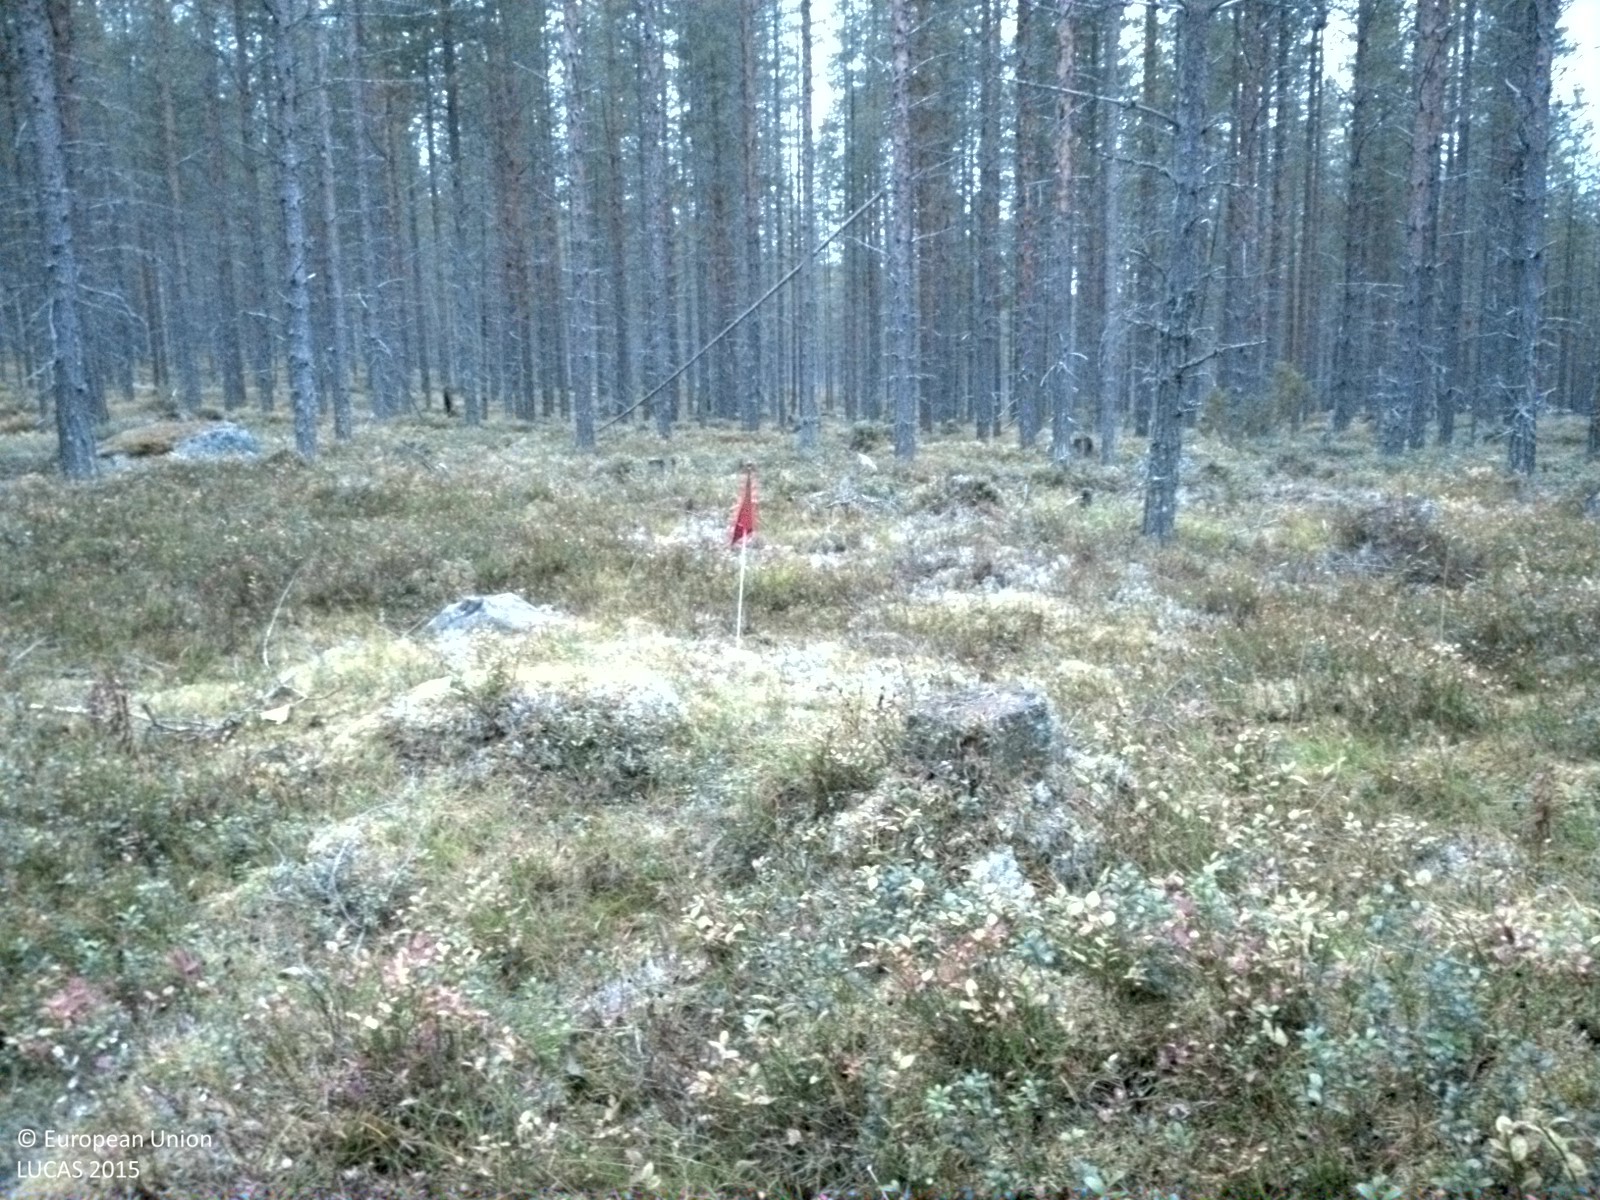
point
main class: Woodland
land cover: Pine dominated coniferous woodland
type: boreal forest
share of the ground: 25 - 50 %
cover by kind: shrubs 60 %, coniferous forest trees 35 %, lichens and mosses 5 %
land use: Forestry
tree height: > 5 m
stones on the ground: 25 - 50 %
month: October
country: SE
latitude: 65.7171
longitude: 20.4028
